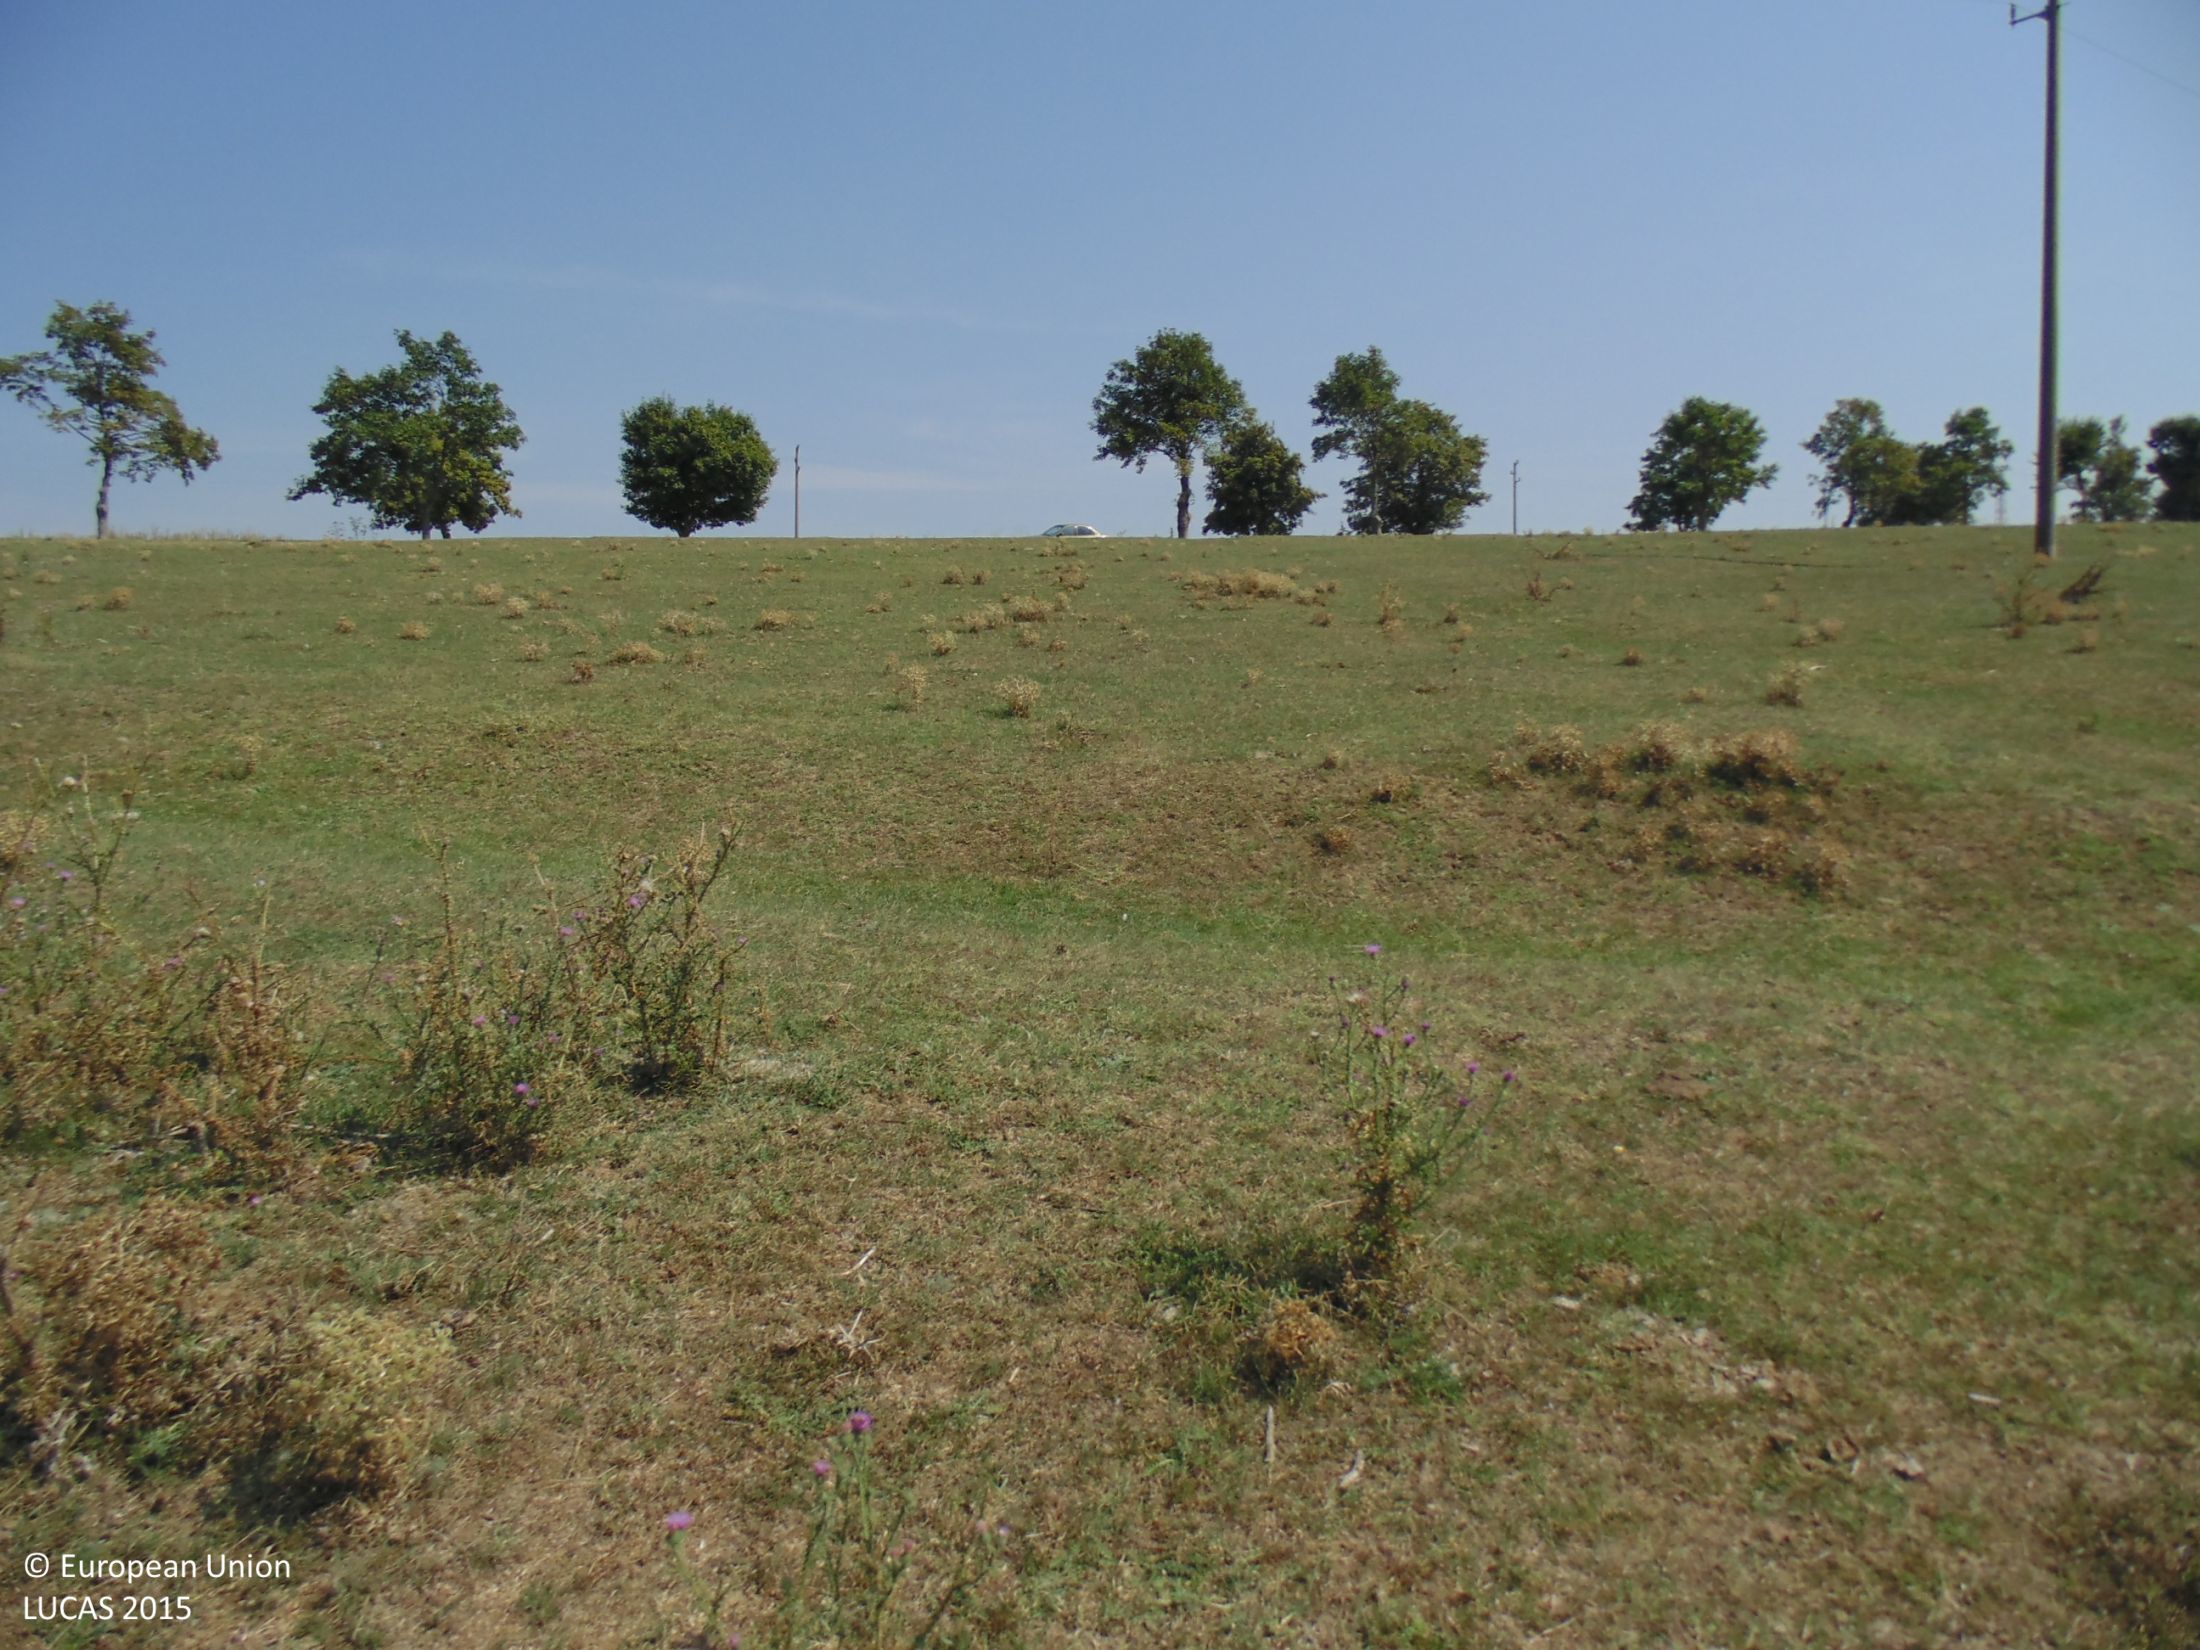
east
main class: Grassland
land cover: Grassland without tree/shrub cover
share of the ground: > 75 %
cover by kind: herbaceous plants 100 %
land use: Agriculture (excluding fallow land and kitchen gardens)
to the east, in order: Grassland without tree/shrub cover; Electric lines; Grassland without tree/shrub cover; Lines of trees; Paved roads, cycling and walking lanes; Lines of trees; Grass margins; Common wheat; Lucerne; Electric lines; Lucerne; Grass margins; Sunflower; Grass margins; Tracks; Grass margins
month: September
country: BG
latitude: 43.7928
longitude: 26.9338
